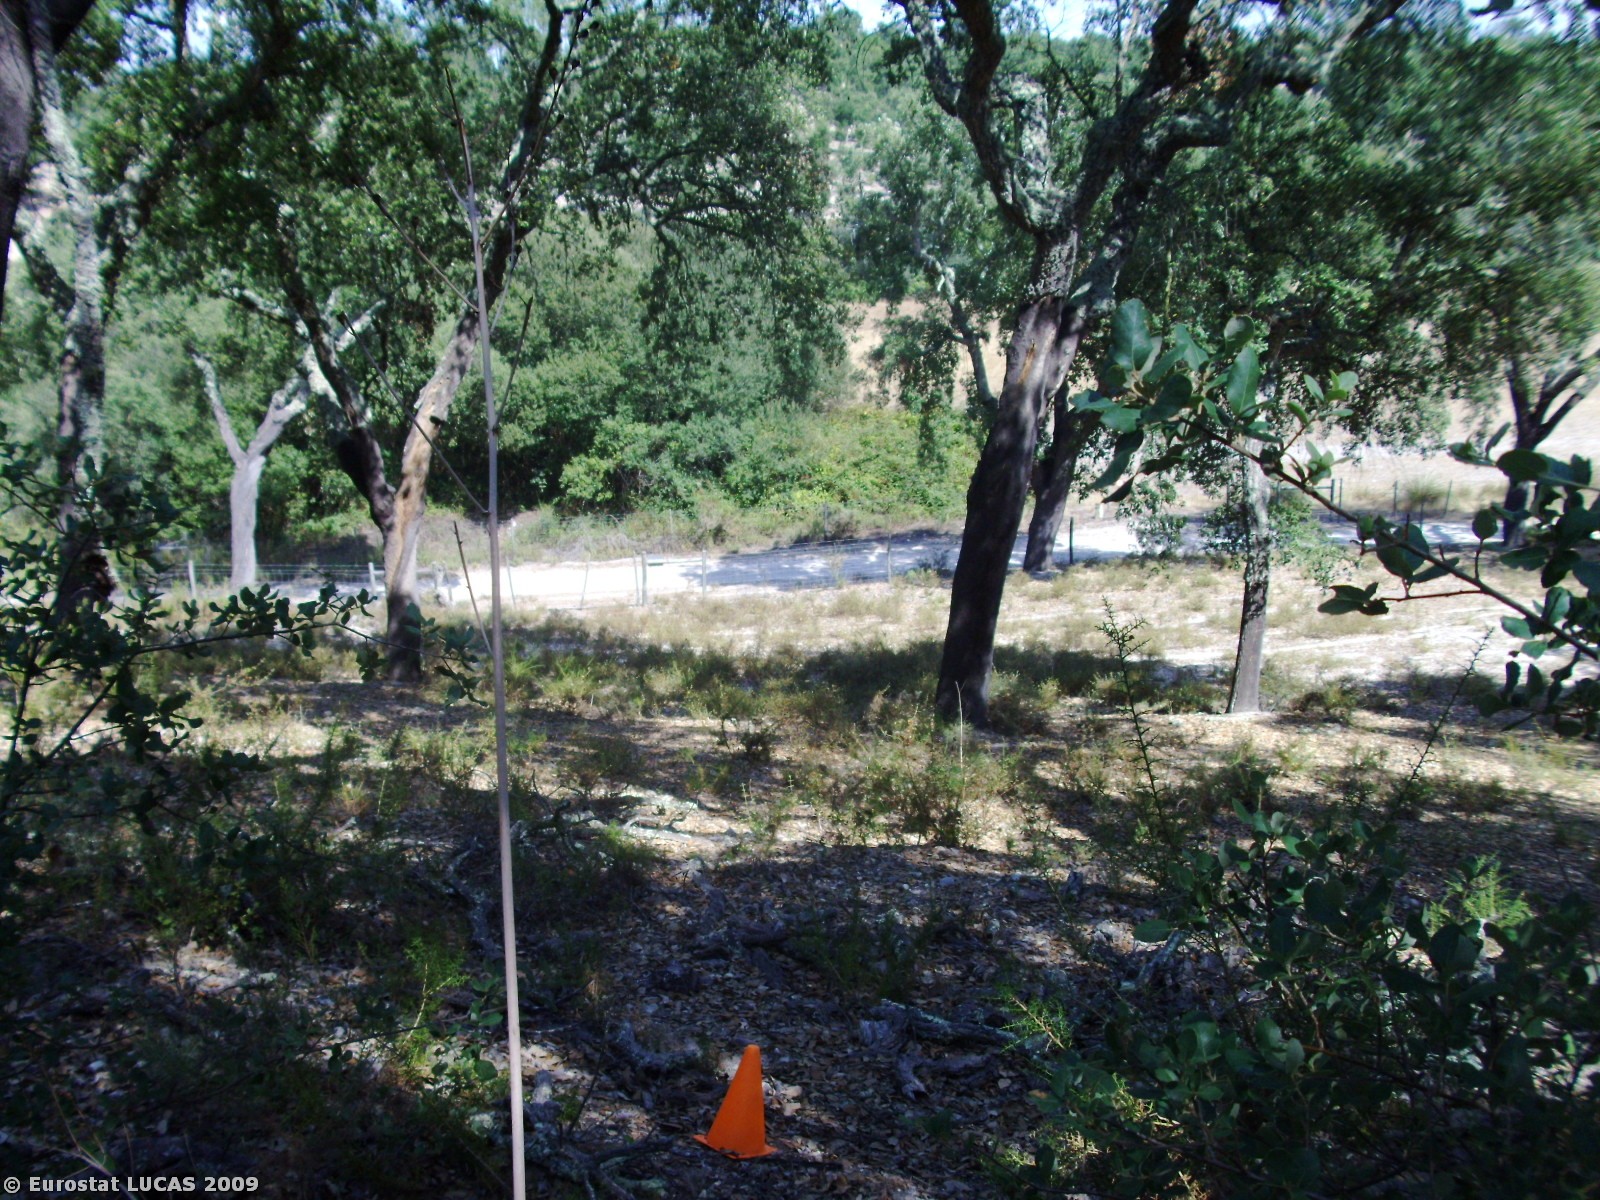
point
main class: Woodland
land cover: Broadleaved woodland
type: broadleaved evergreen forest
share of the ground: > 75 %
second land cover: Spontaneously vegetated surfaces
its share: 10 - 25 %
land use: Forestry
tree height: > 5 m
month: August
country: PT
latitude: 39.3132
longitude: -8.0692
